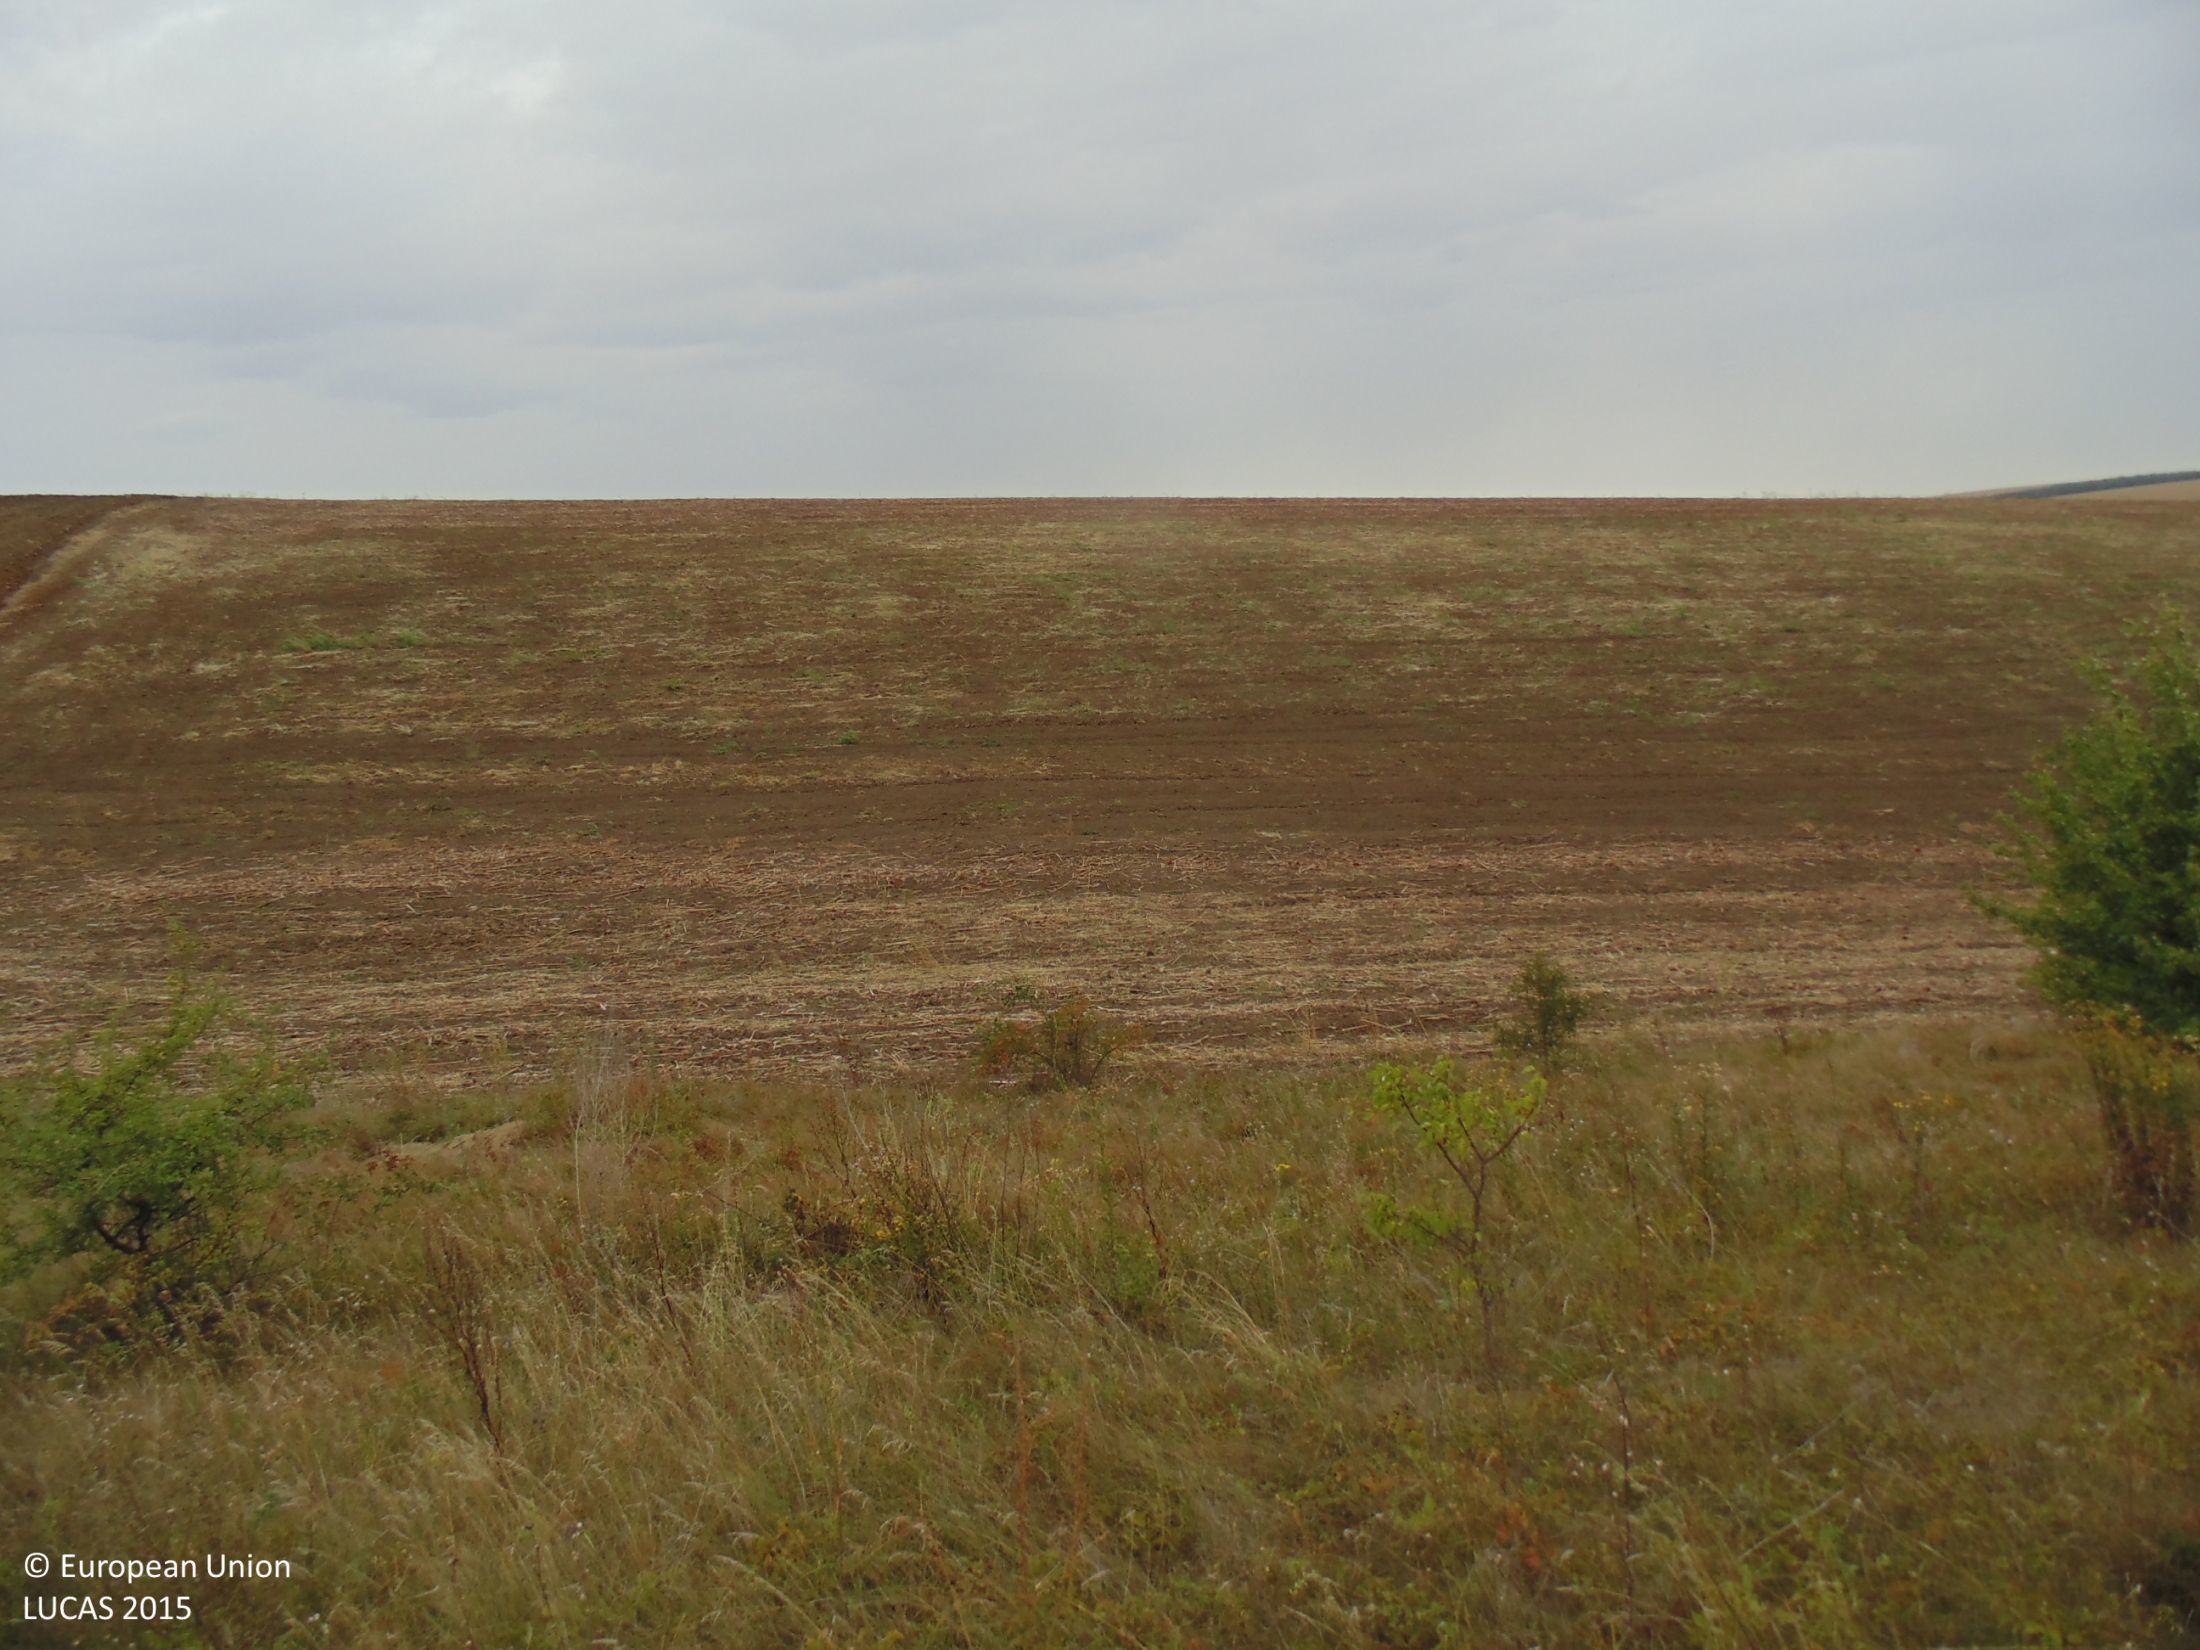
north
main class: Grassland
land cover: Grassland with sparse tree/shrub cover
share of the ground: > 75 %
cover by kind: herbaceous plants 85 %, shrubs 10 %, broadleaved forest trees 5 %
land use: Semi-natural and natural areas not in use
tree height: < 5 m
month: September
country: BG
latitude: 43.9976
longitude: 26.9187
